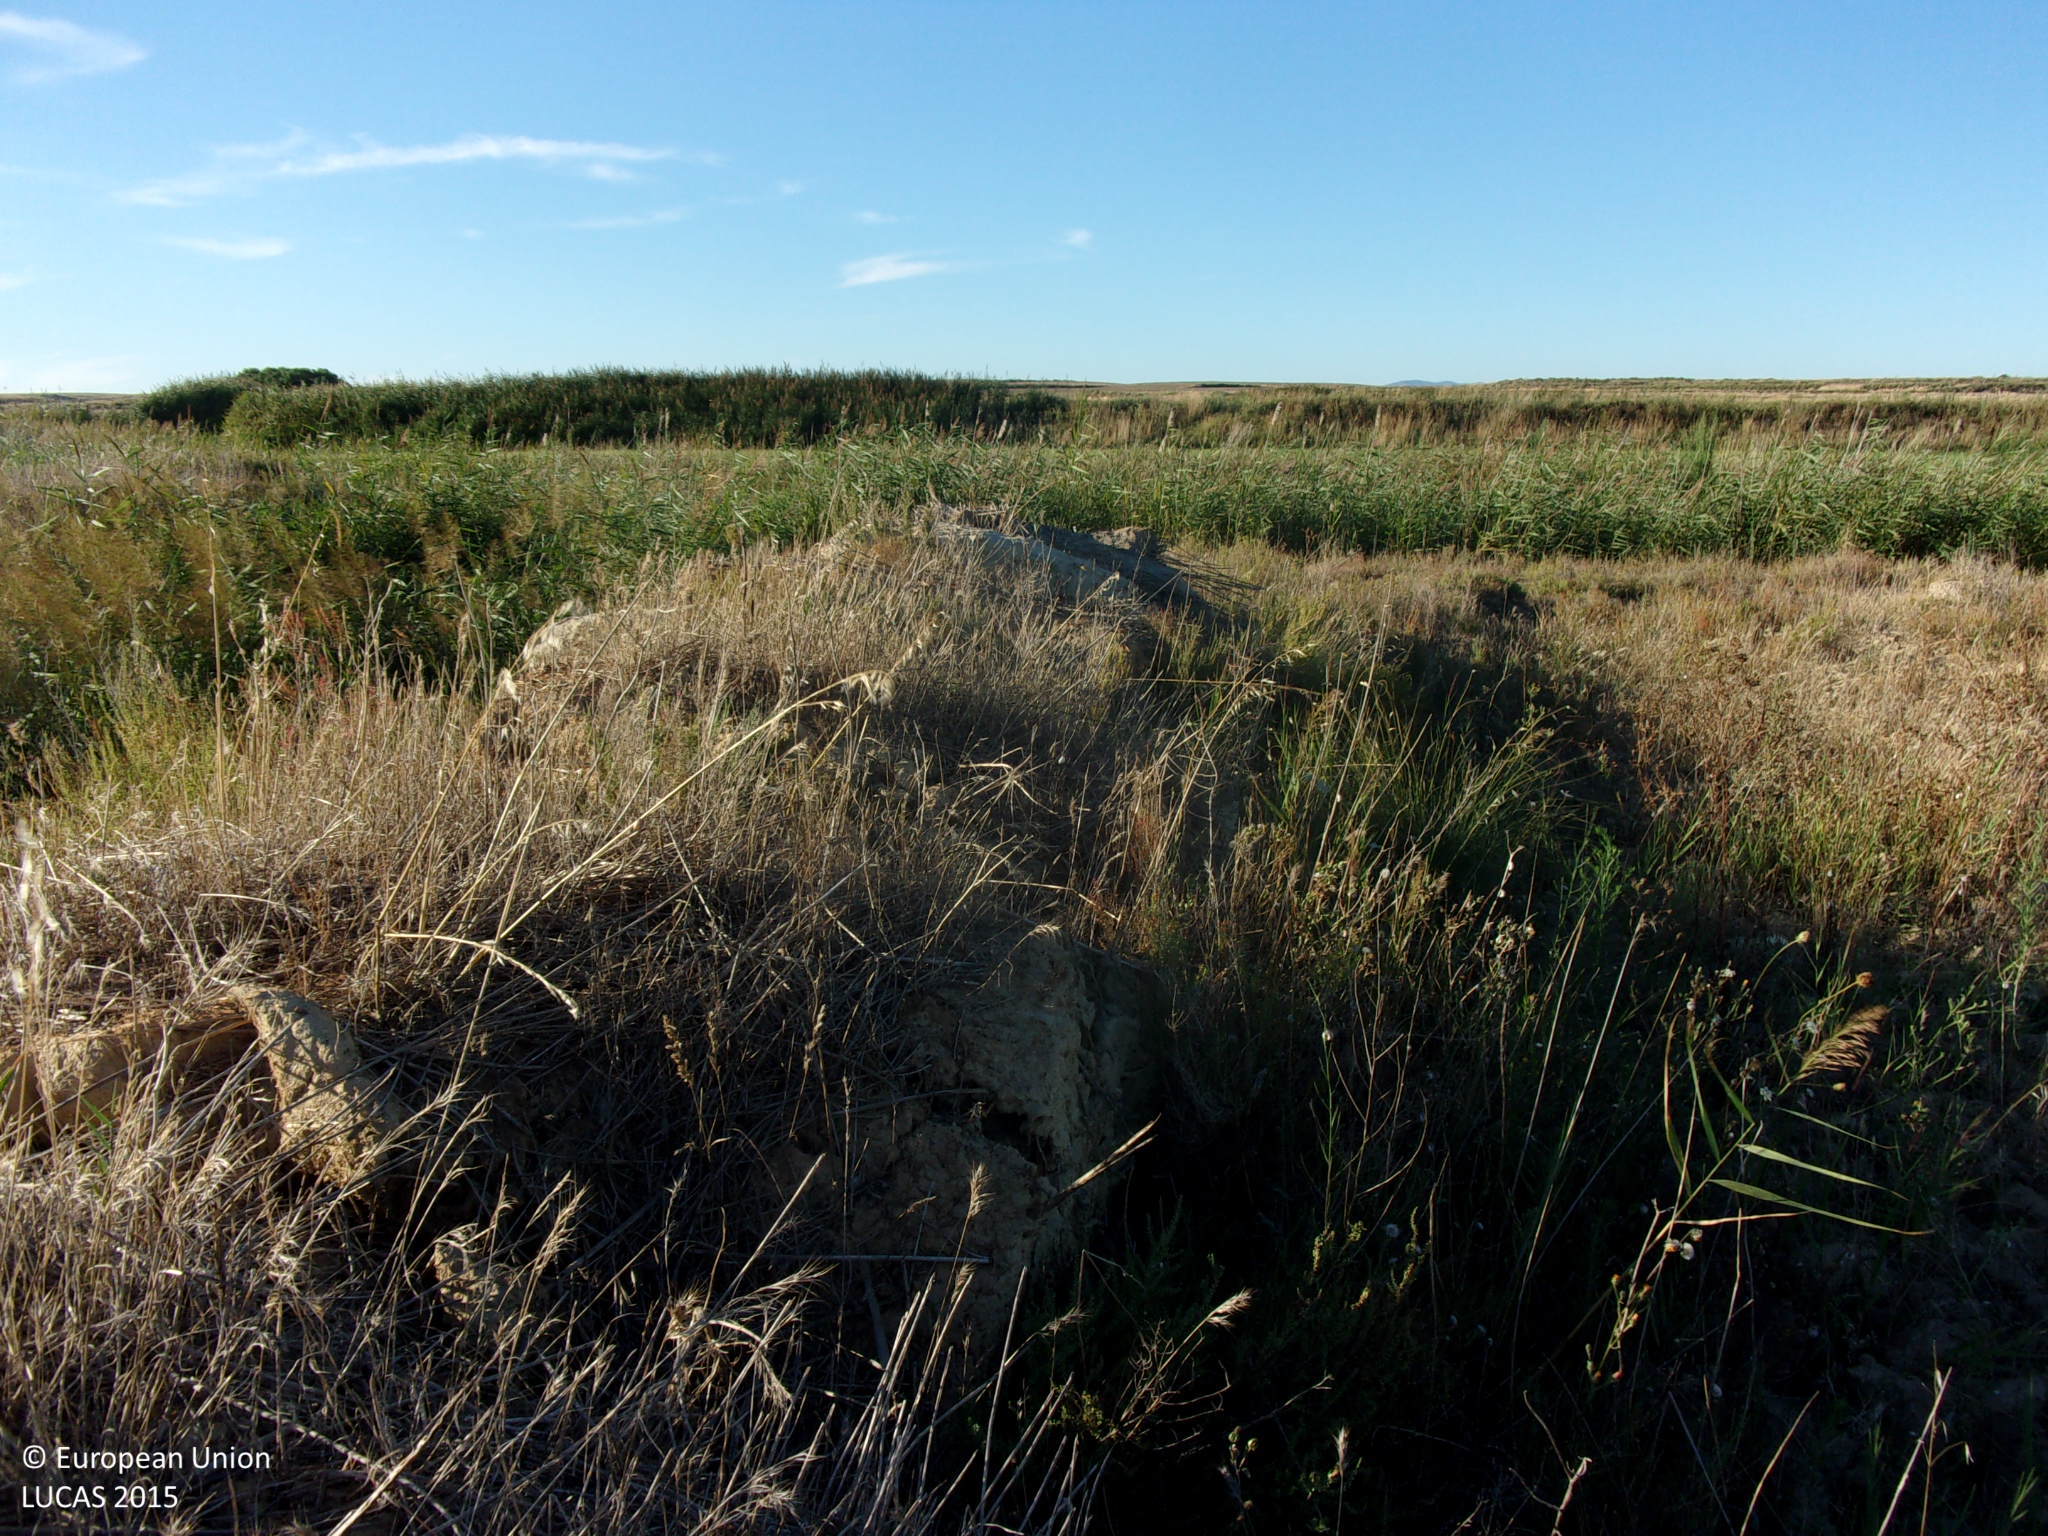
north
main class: Grassland
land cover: Grassland without tree/shrub cover
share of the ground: > 75 %
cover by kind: herbaceous plants 100 %
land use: Abandoned areas
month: August
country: ES
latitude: 42.2670
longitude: -1.3671
